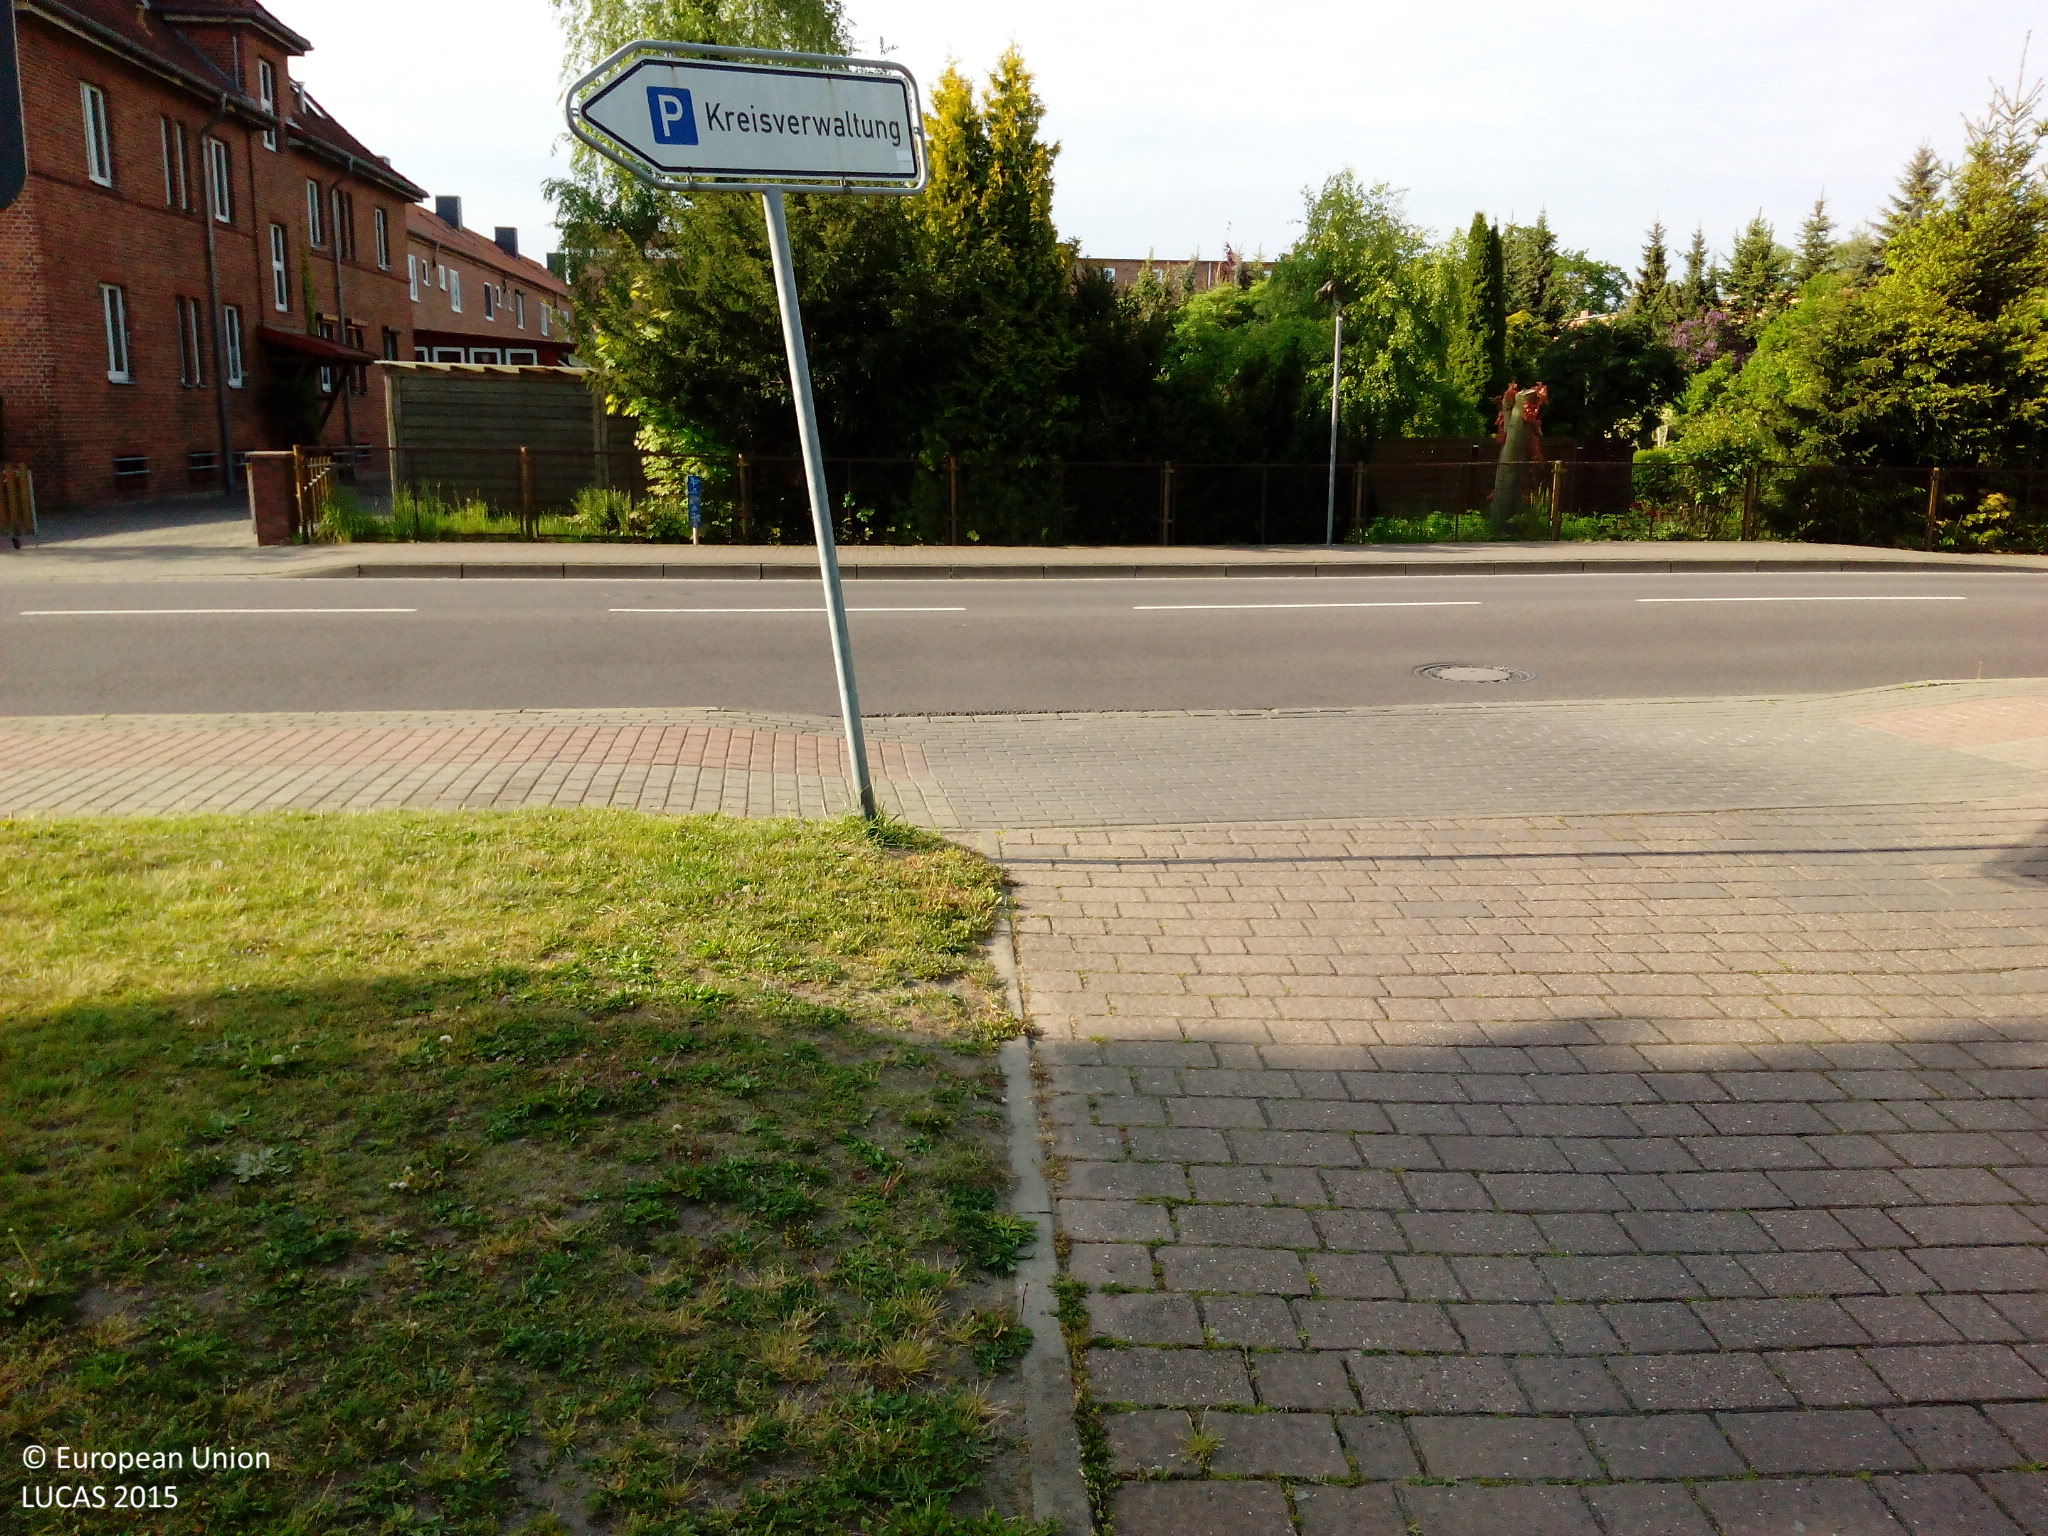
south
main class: Grassland
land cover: Grassland with sparse tree/shrub cover
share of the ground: > 75 %
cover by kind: herbaceous plants 80 %, coniferous forest trees 5 %, lichens and mosses 5 %, unconsolidated bare surface 5 %
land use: Community services
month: May
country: DE
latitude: 52.8573
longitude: 11.1431
